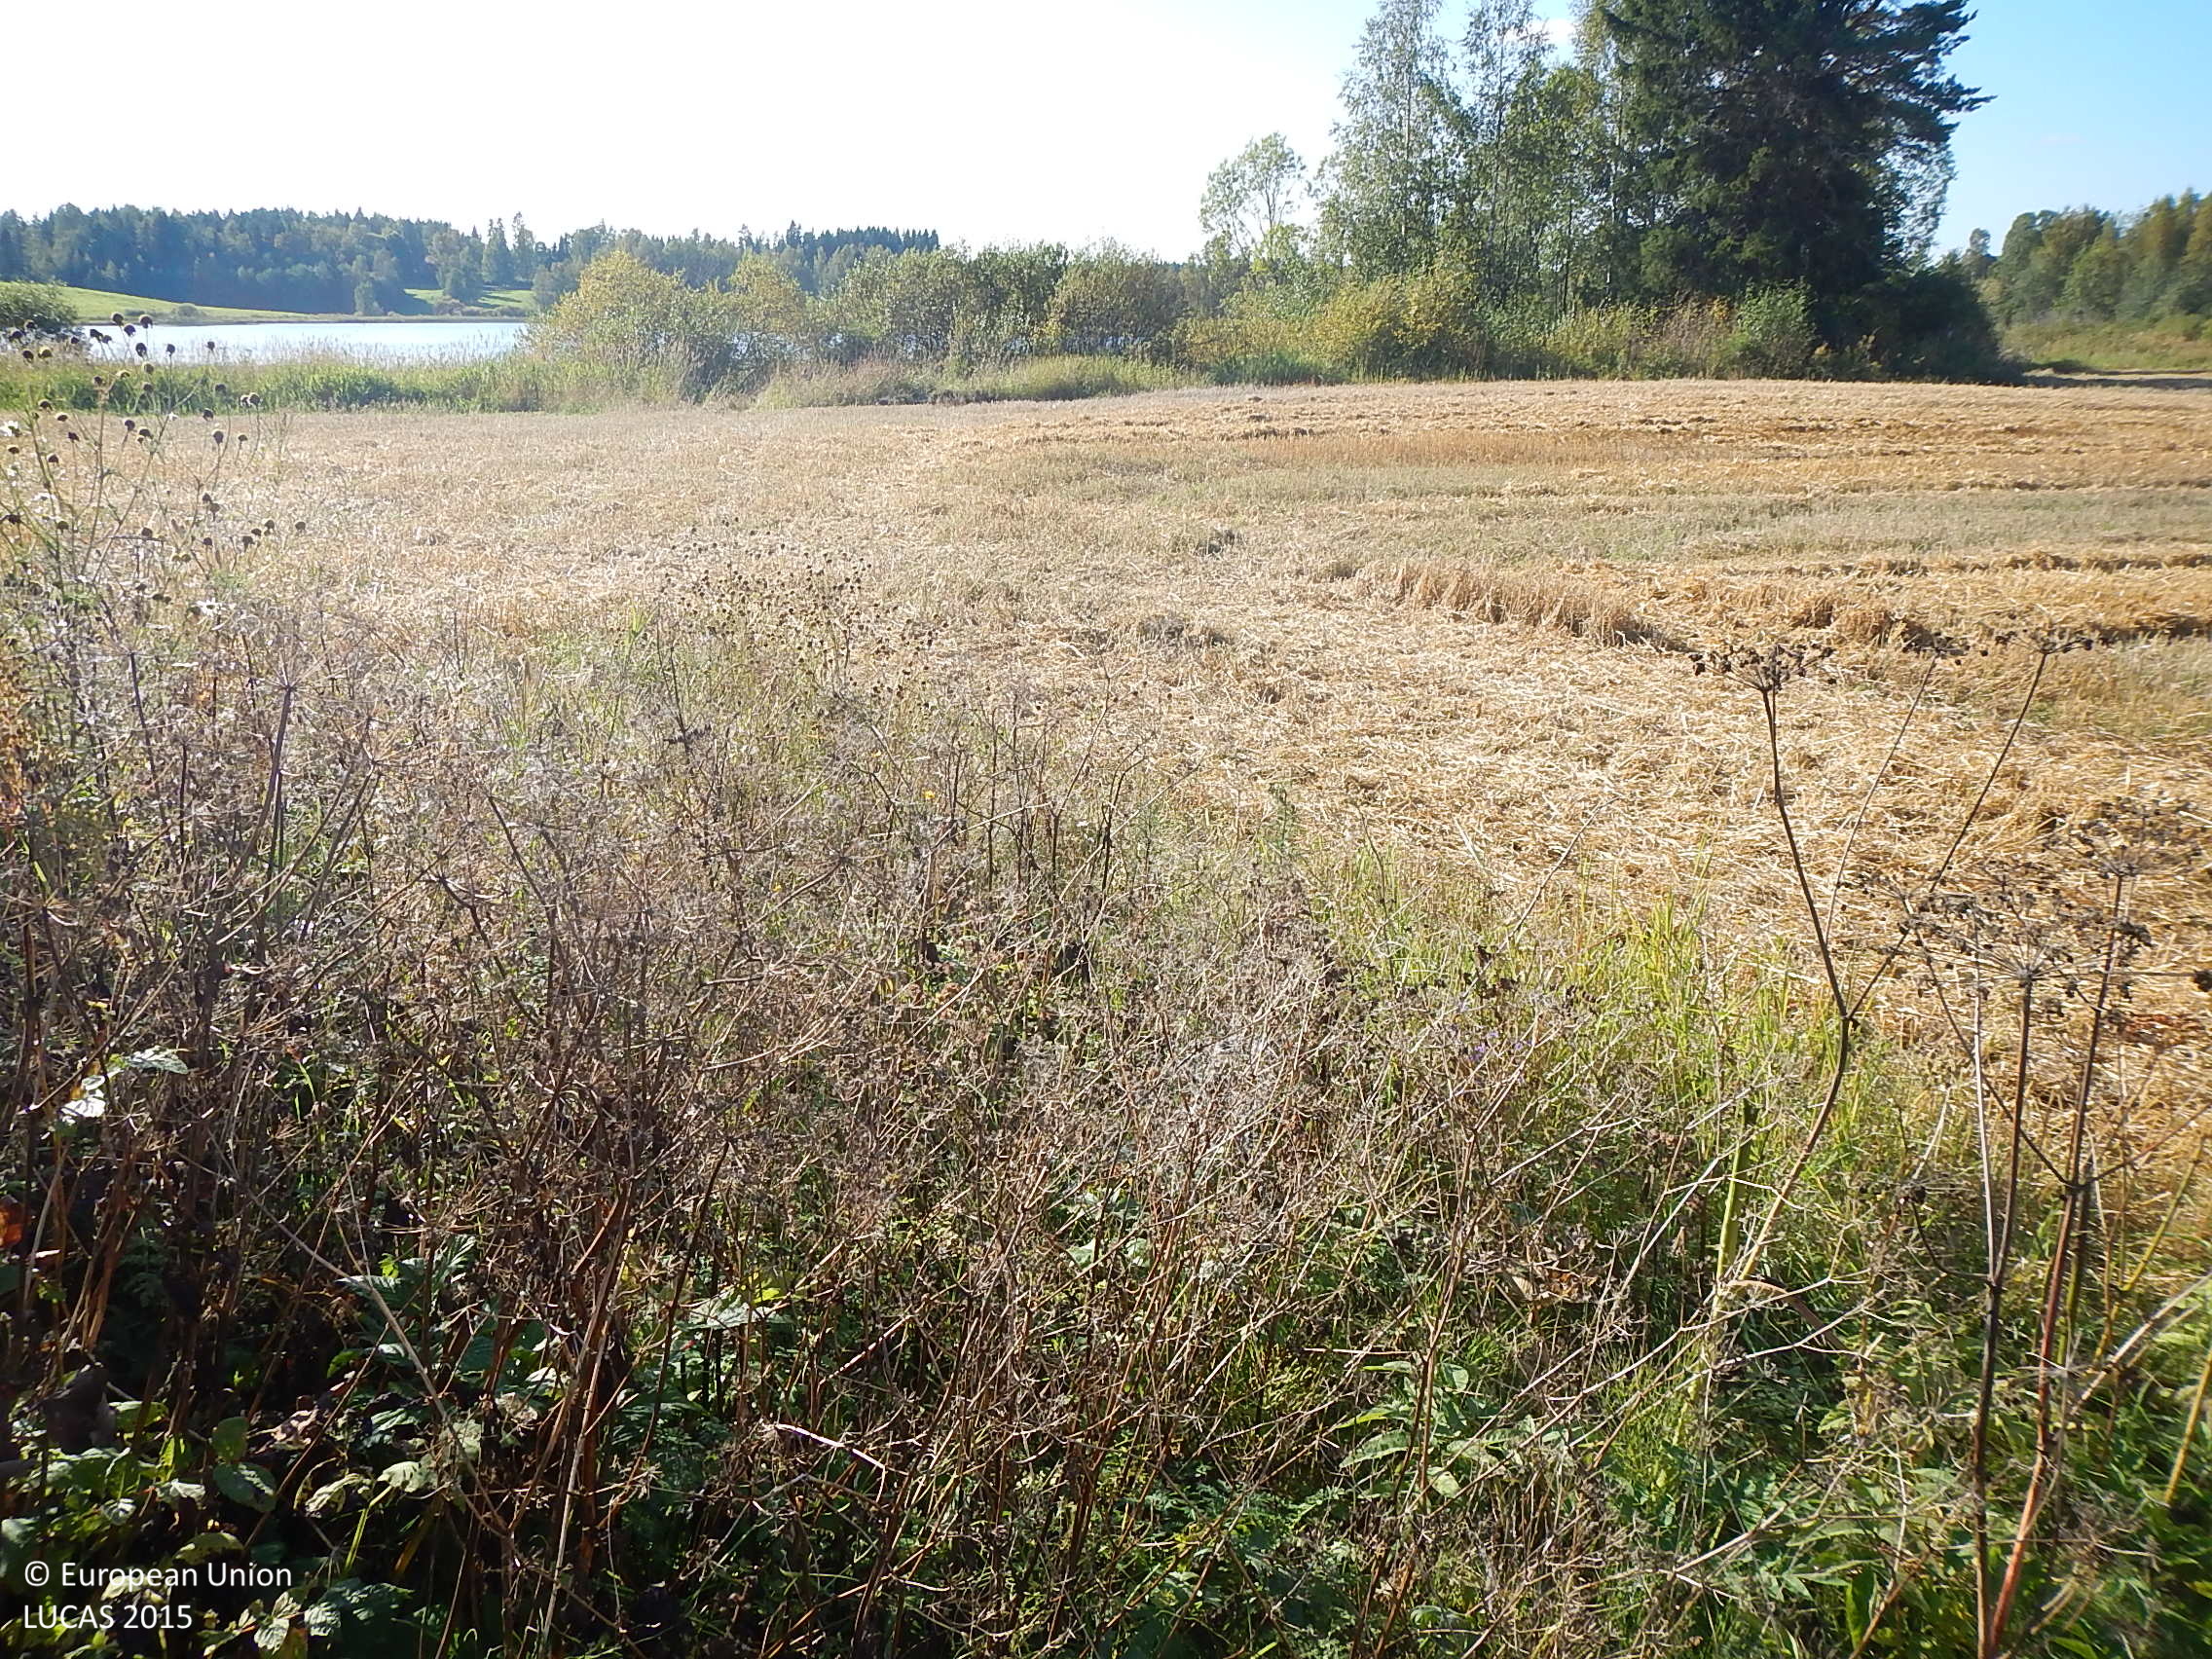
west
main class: Grassland
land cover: Spontaneously vegetated surfaces
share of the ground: > 75 %
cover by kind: herbaceous plants 100 %
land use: Semi-natural and natural areas not in use
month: September
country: FI
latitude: 61.6450
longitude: 22.7690
